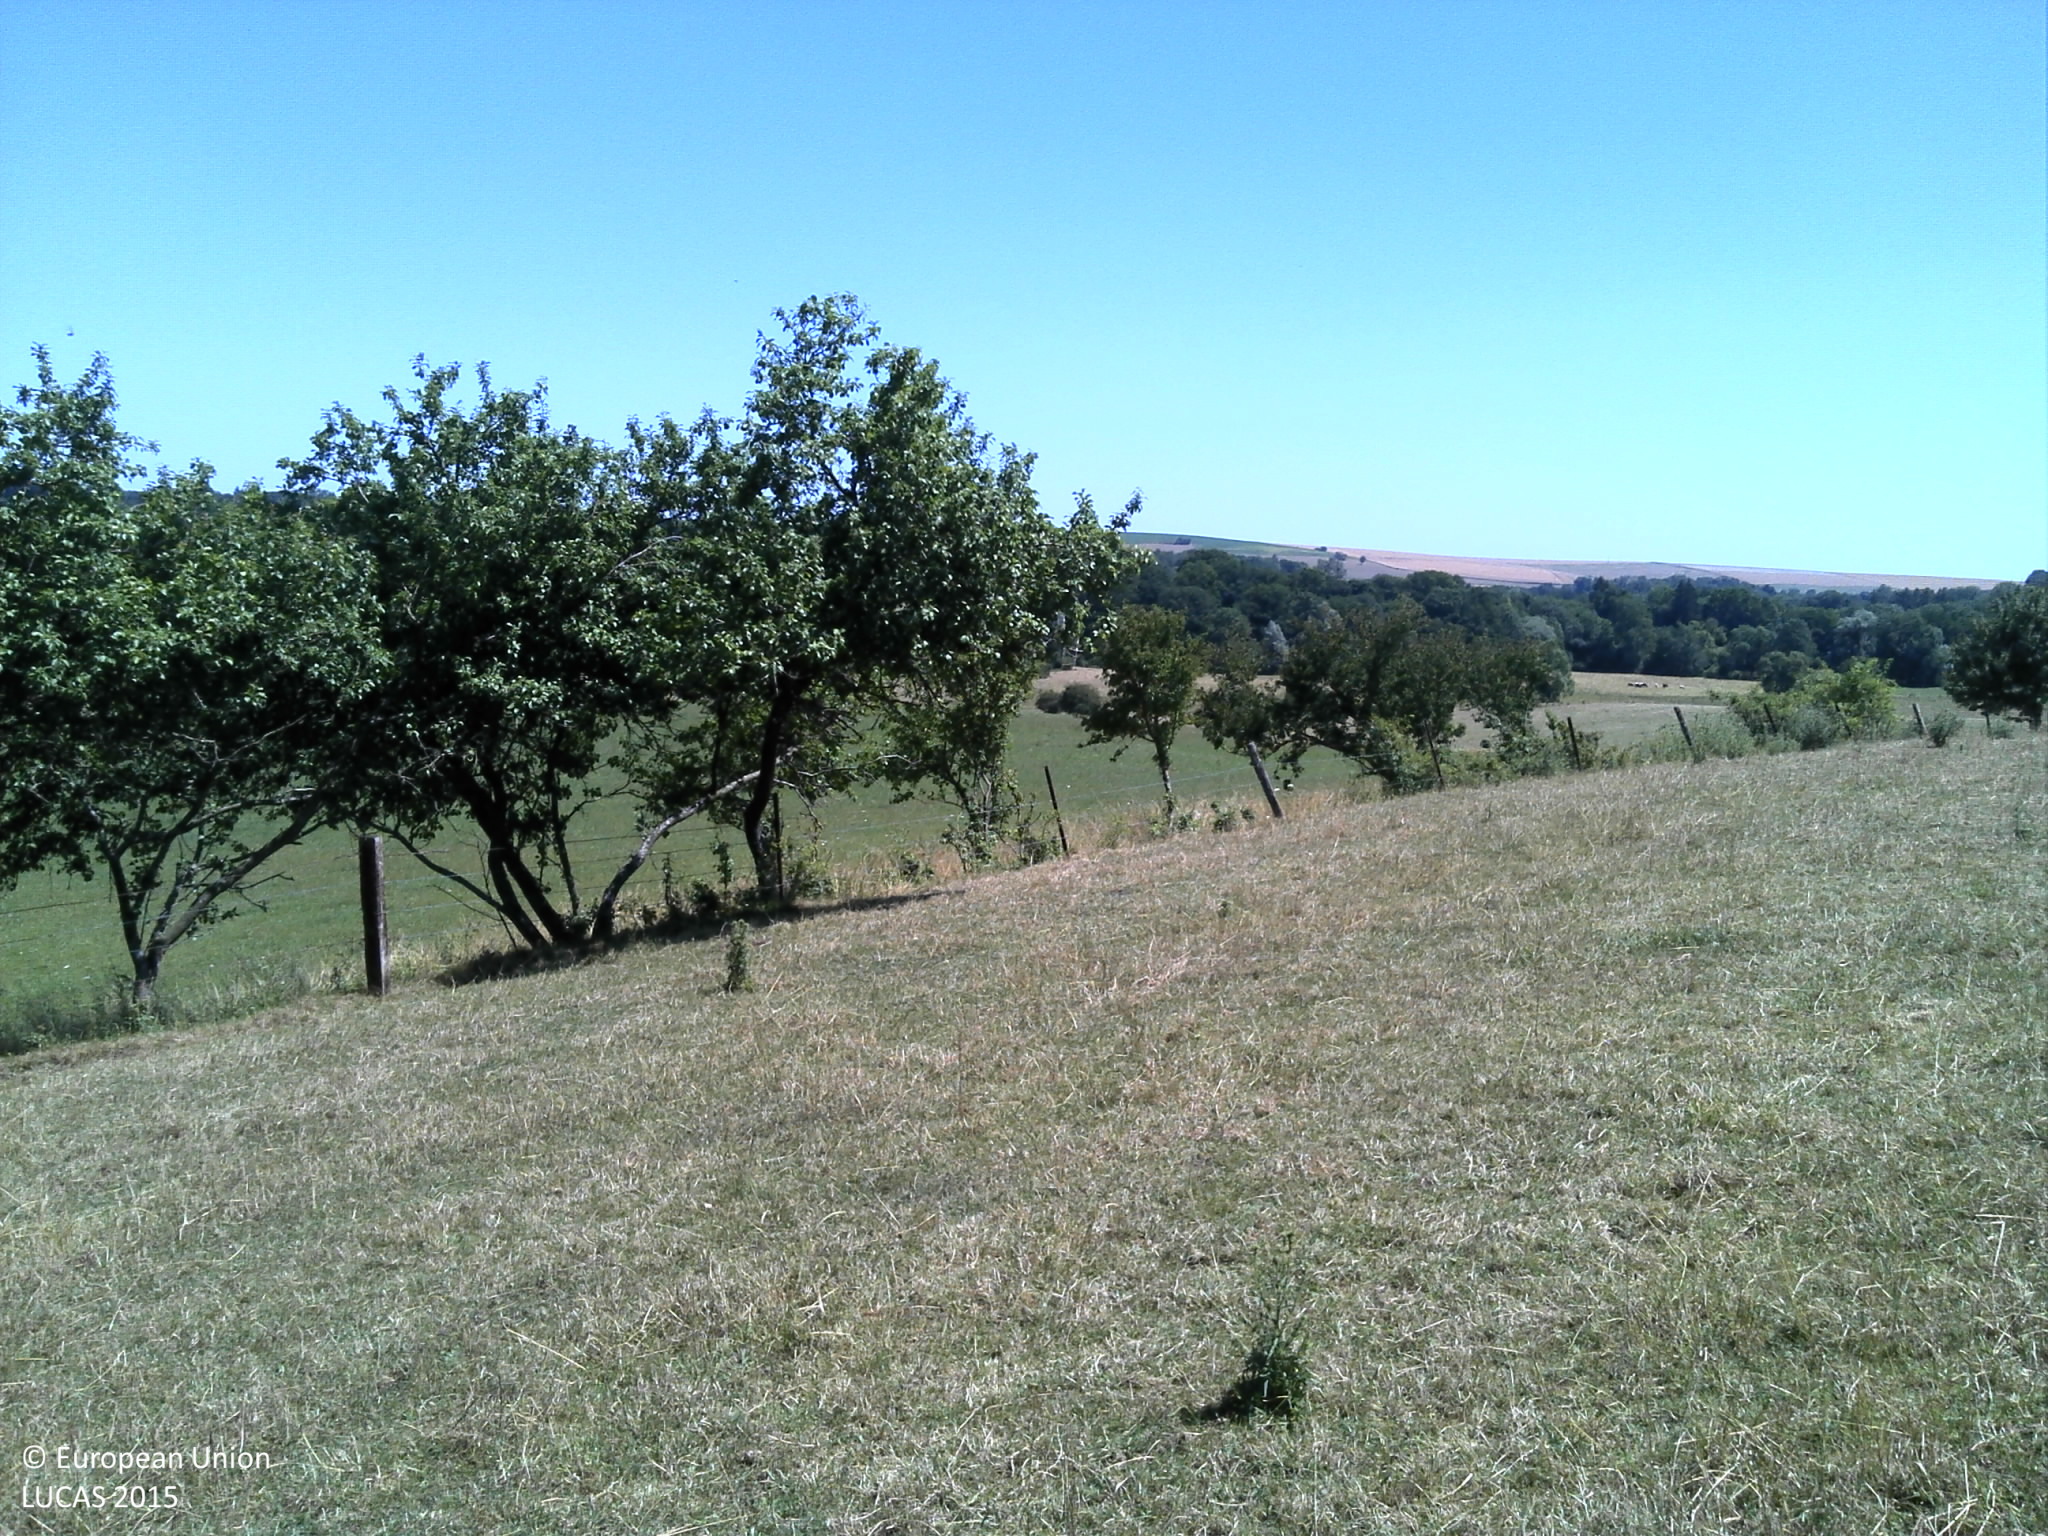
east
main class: Grassland
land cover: Grassland with sparse tree/shrub cover
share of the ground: > 75 %
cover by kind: herbaceous plants 95 %, broadleaved forest trees 5 %
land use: Agriculture (excluding fallow land and kitchen gardens)
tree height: > 5 m
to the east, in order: Grassland with sparse tree/shrub cover; Grassland without tree/shrub cover; Fences; Single bushes/trees; Tracks; Grassland without tree/shrub cover
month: July
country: FR
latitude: 49.5578
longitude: 4.7298
